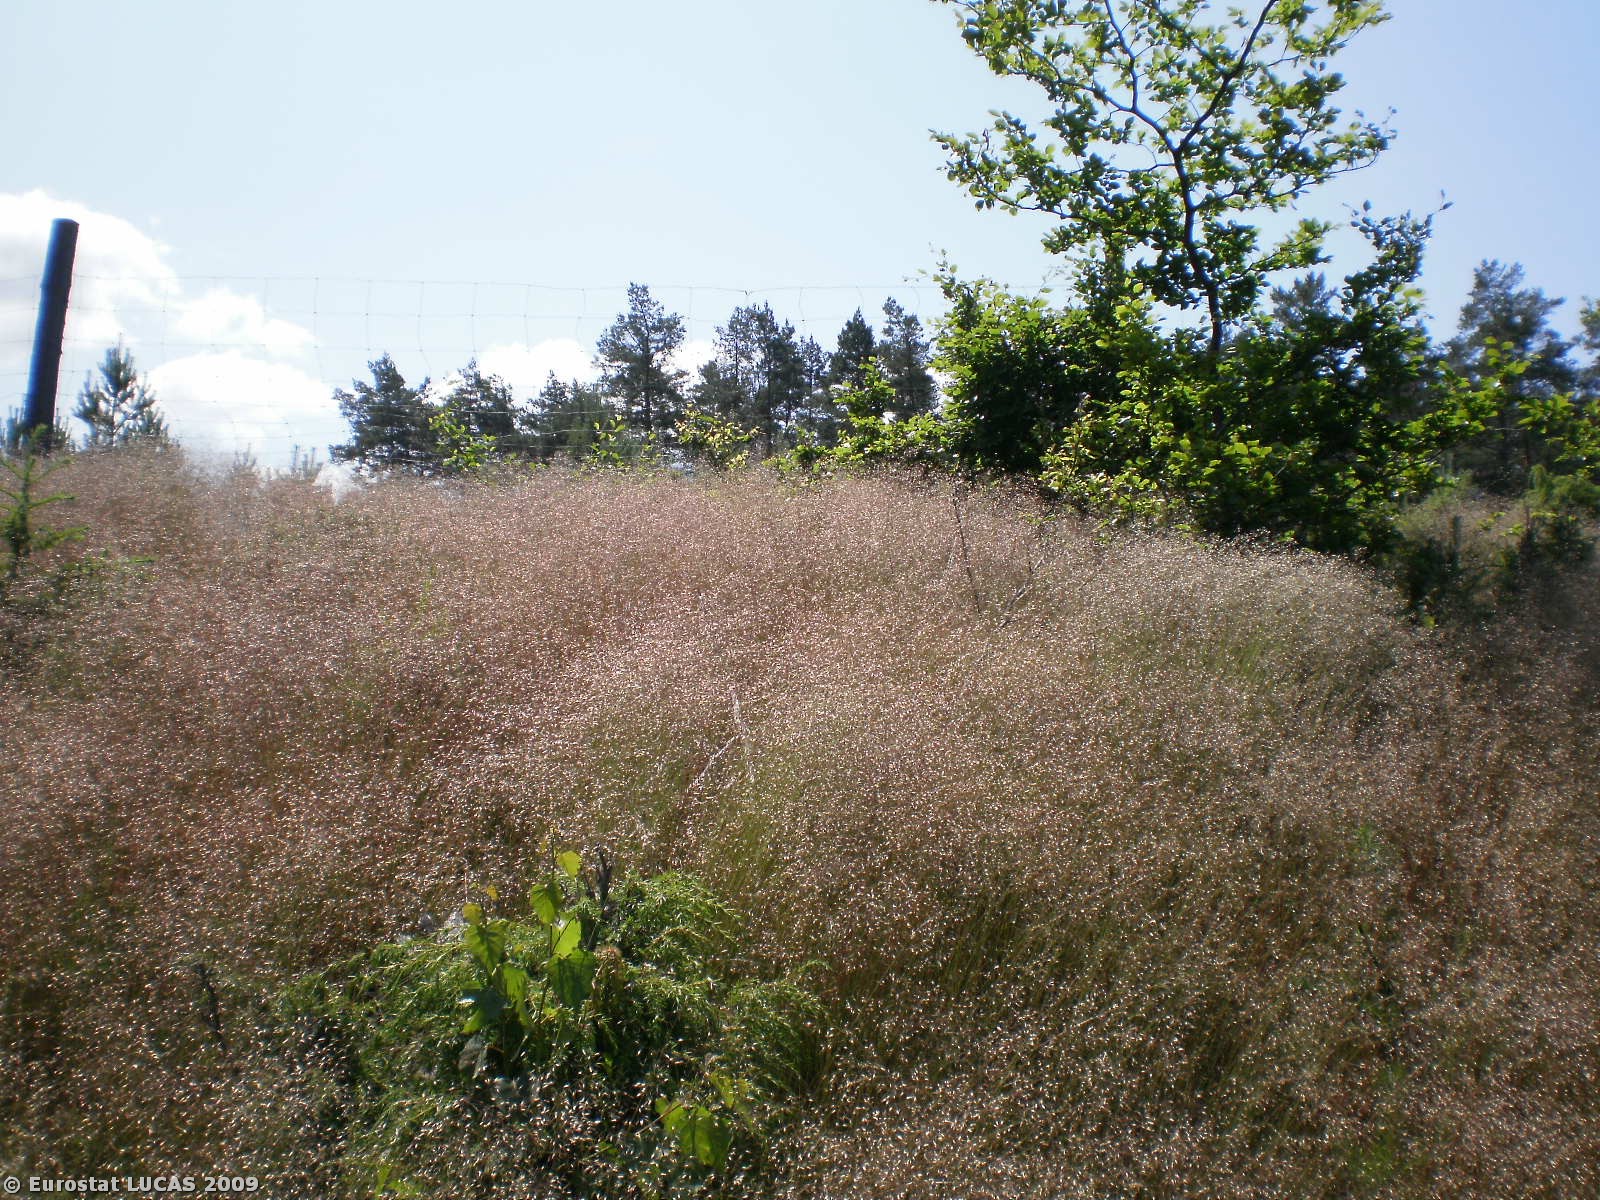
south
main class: Grassland
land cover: Grassland with sparse tree/shrub cover
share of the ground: > 75 %
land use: Forestry
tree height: > 5 m
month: July
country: PL
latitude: 54.2306
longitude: 17.2657
